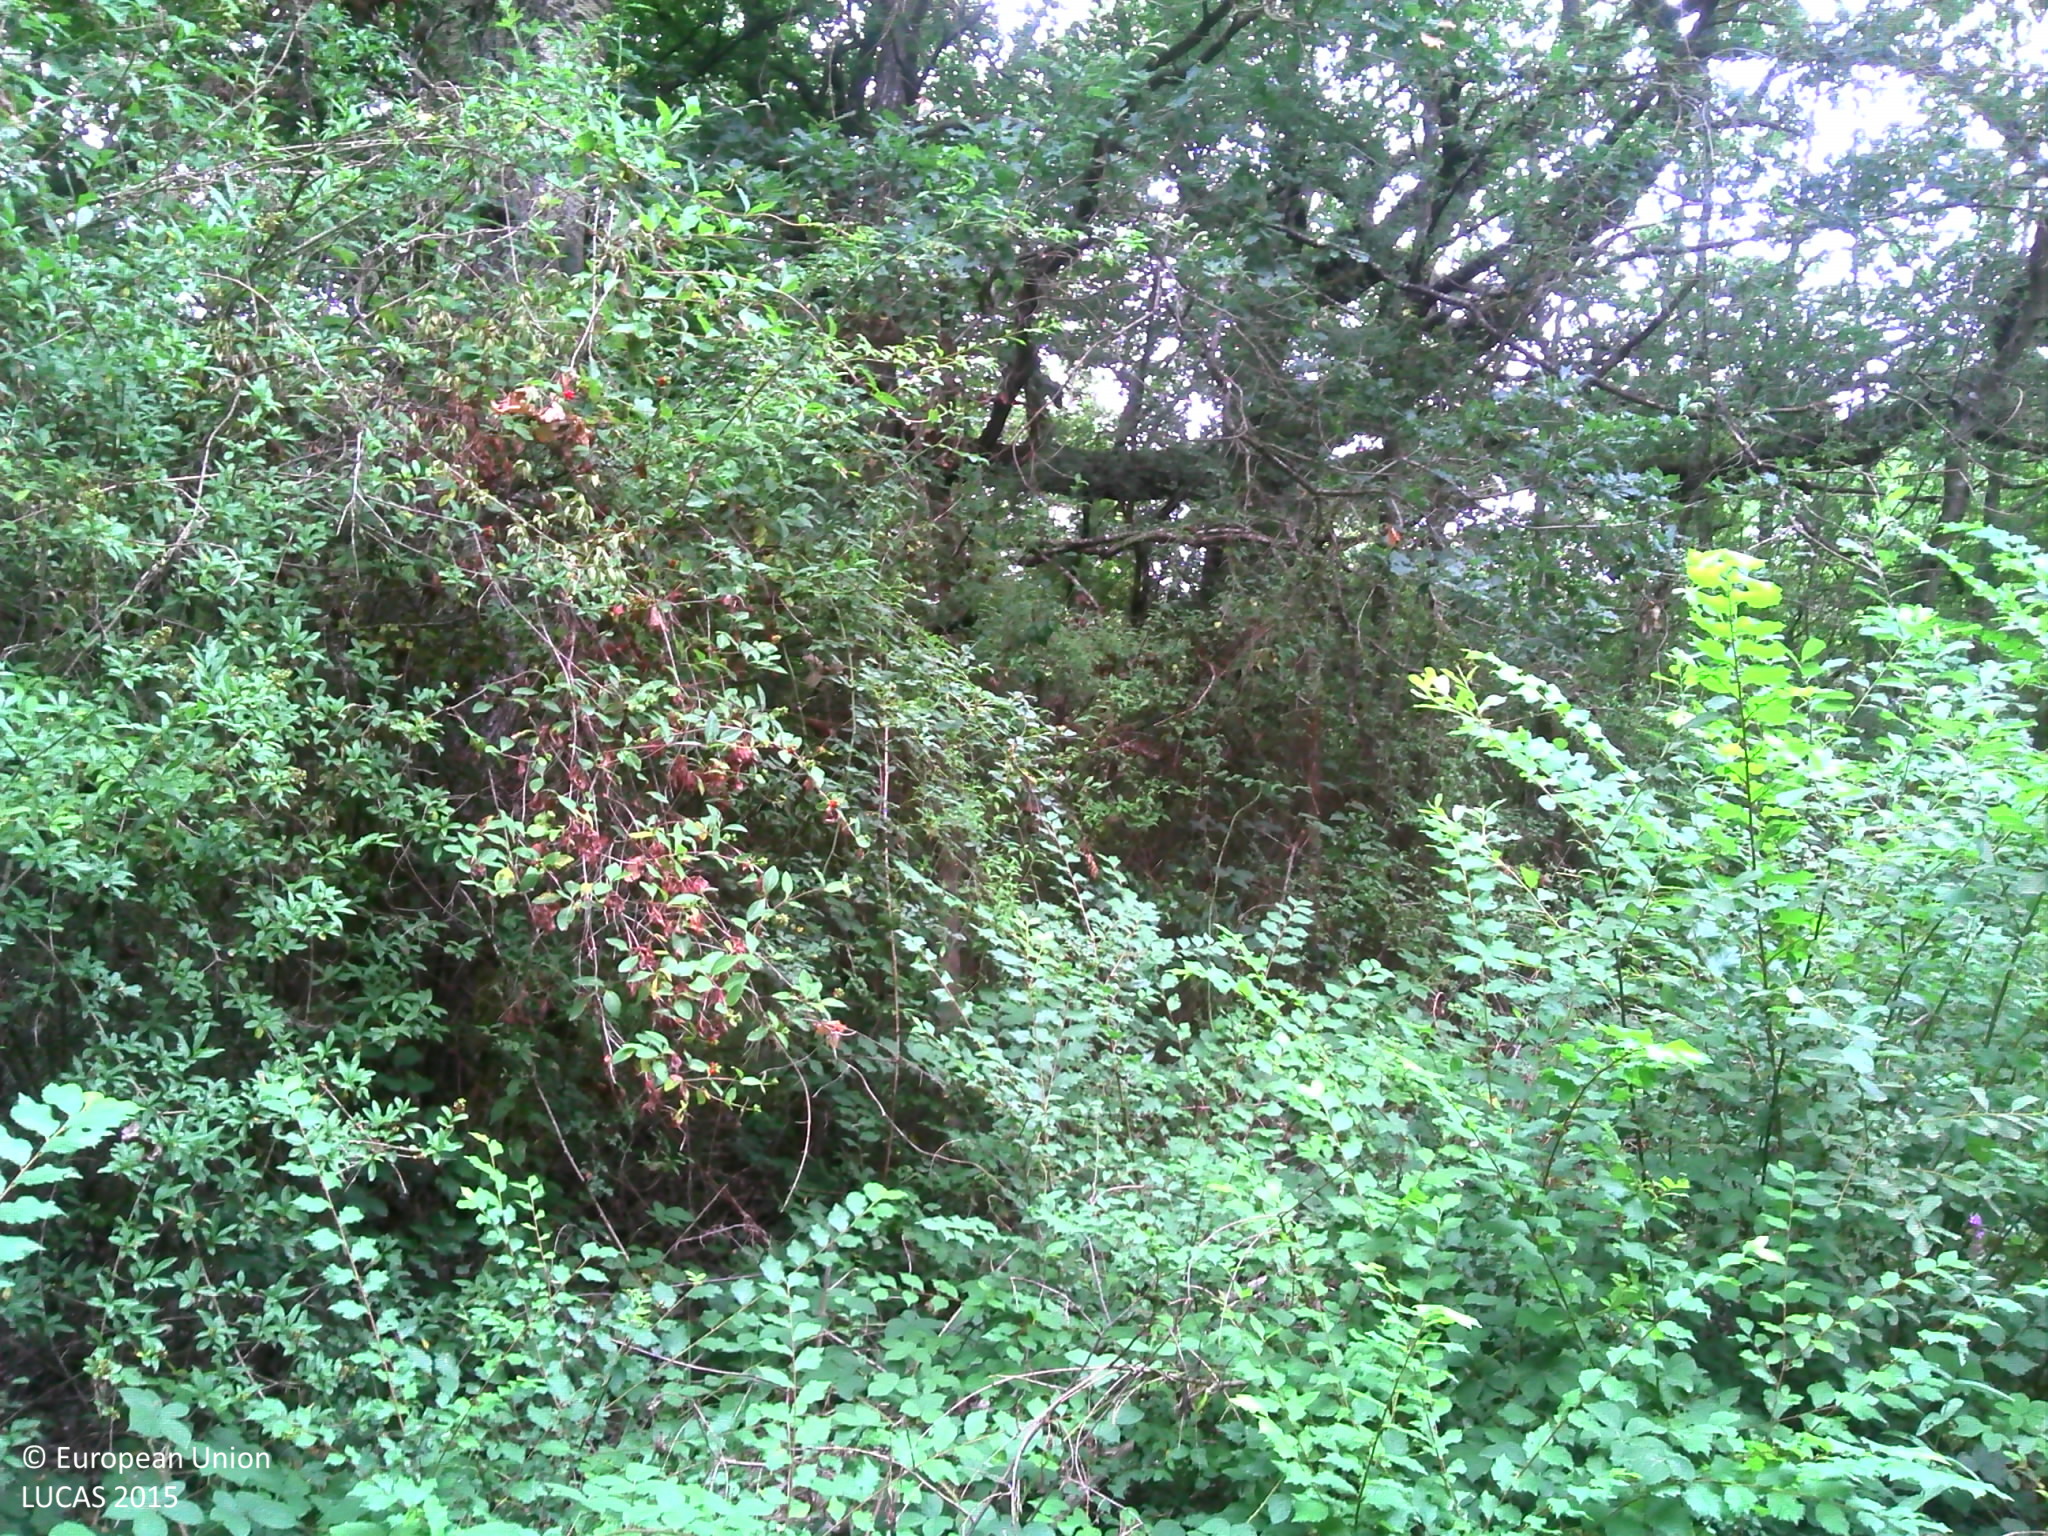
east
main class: Woodland
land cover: Broadleaved woodland
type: acidophilous oak and oak-birch forest
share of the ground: > 75 %
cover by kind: broadleaved forest trees 65 %, lichens and mosses 15 %, herbaceous plants 10 %, consolidated bare surface 5 %, unconsolidated bare surface 5 %
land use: Community services
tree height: > 5 m
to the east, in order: Broadleaved woodland; Paved roads, cycling and walking lanes; Fences; Ditches and canals; Grass margins; Fences; Broadleaved woodland; Fences; Grass margins; Tracks; Shrubland with sparse tree cover; Broadleaved woodland
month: July
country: FR
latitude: 48.5515
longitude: 2.5792
